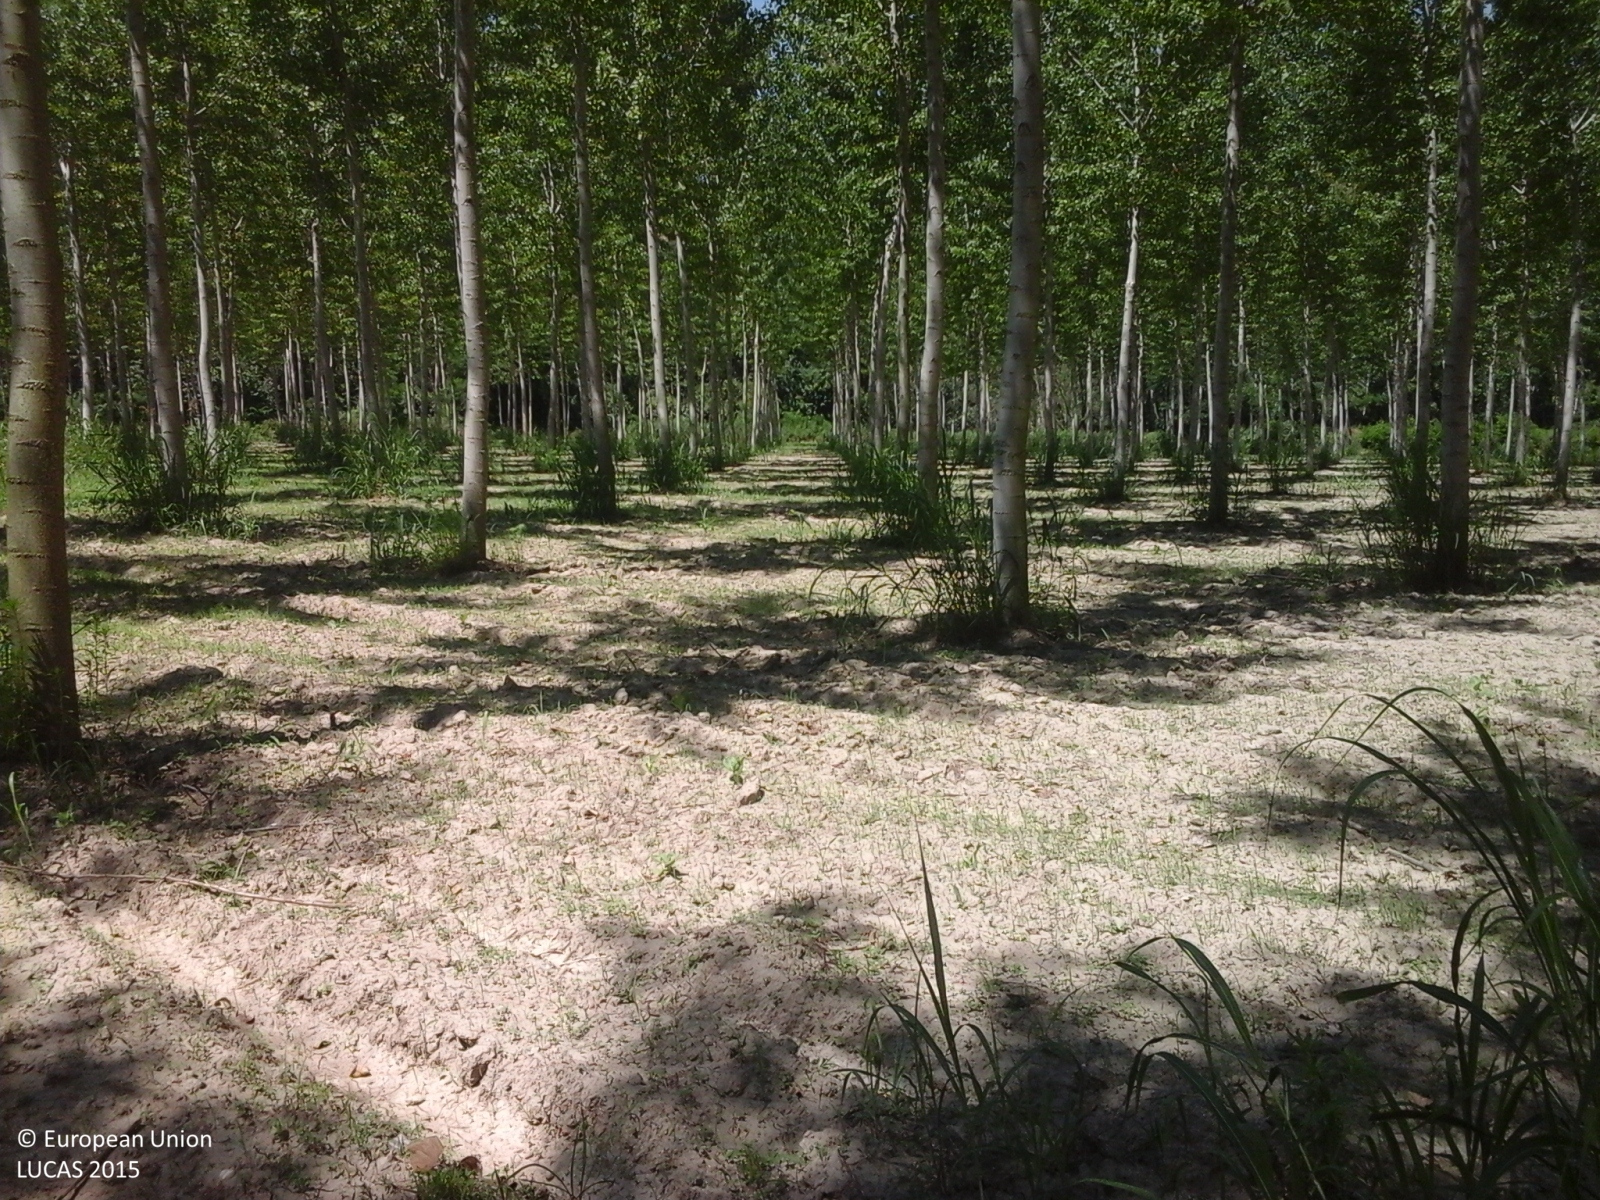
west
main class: Woodland
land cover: Broadleaved woodland
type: non-riverine alder, birch or aspen forest
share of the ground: > 75 %
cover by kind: broadleaved forest trees 85 %, unconsolidated bare surface 15 %
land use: Forestry
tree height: > 5 m
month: June
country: IT
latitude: 45.0450
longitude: 8.6441
